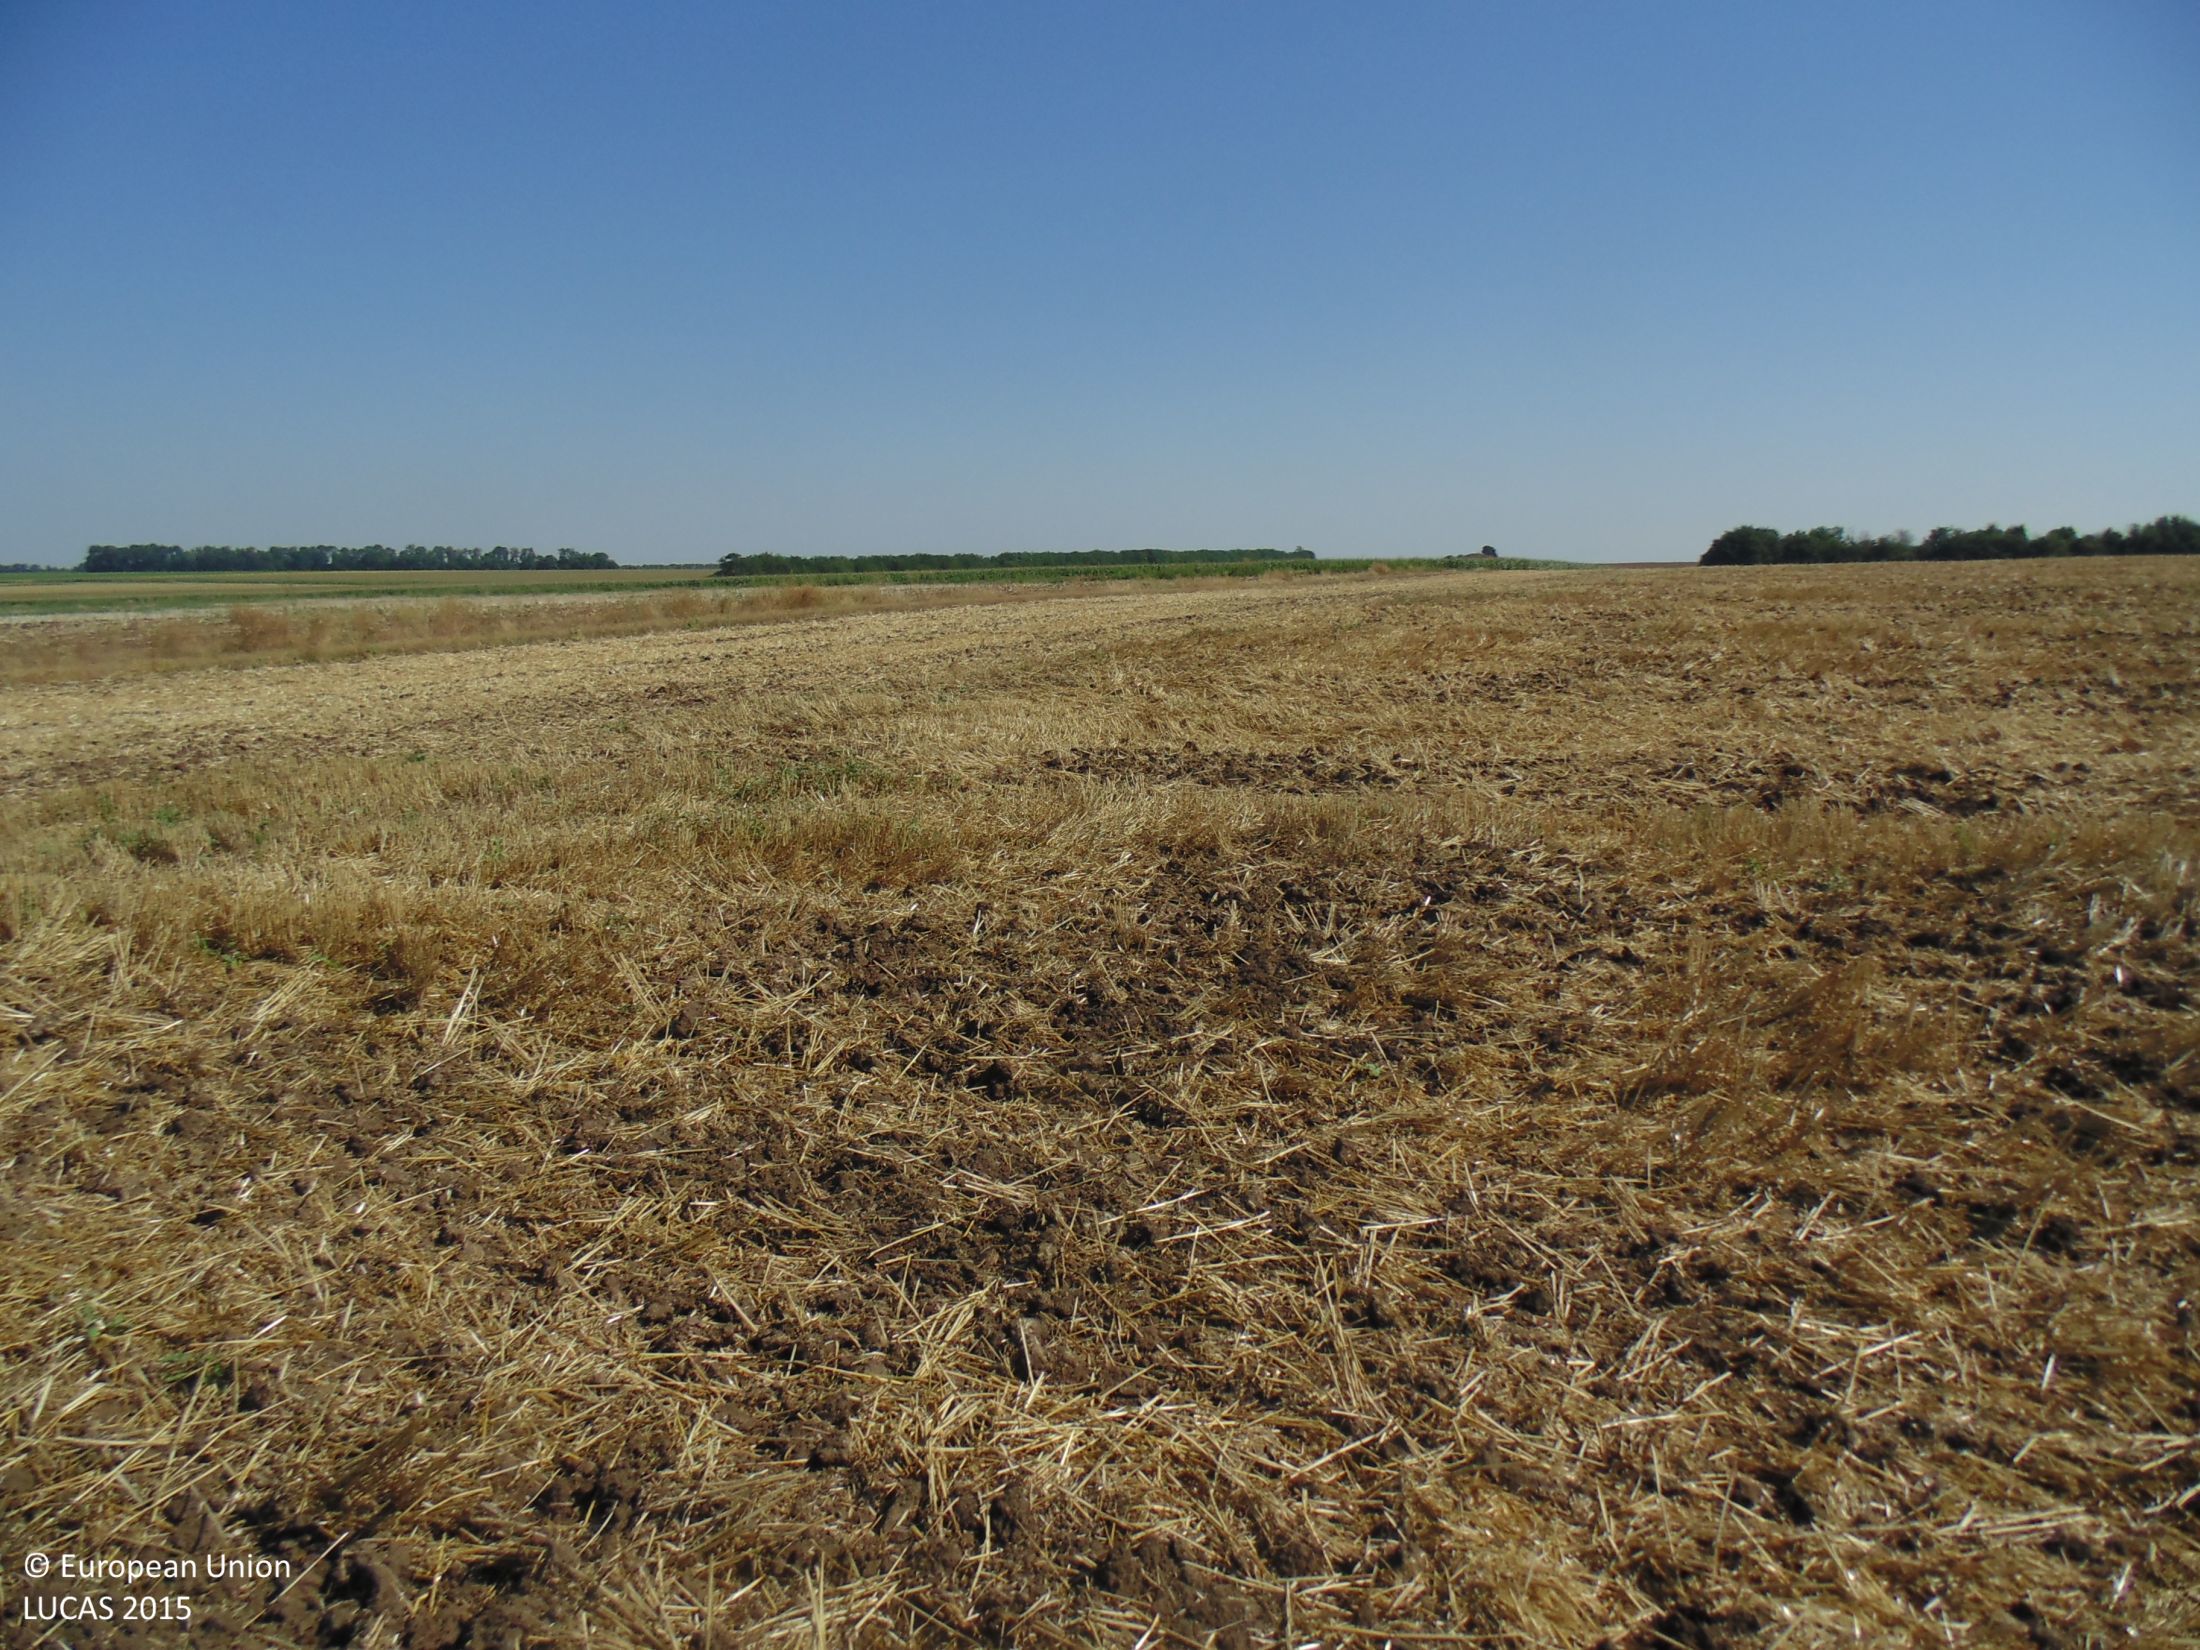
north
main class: Cropland
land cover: Common wheat
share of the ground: 10 - 25 %
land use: Agriculture (excluding fallow land and kitchen gardens)
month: July
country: BG
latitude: 43.5434
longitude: 27.9543
